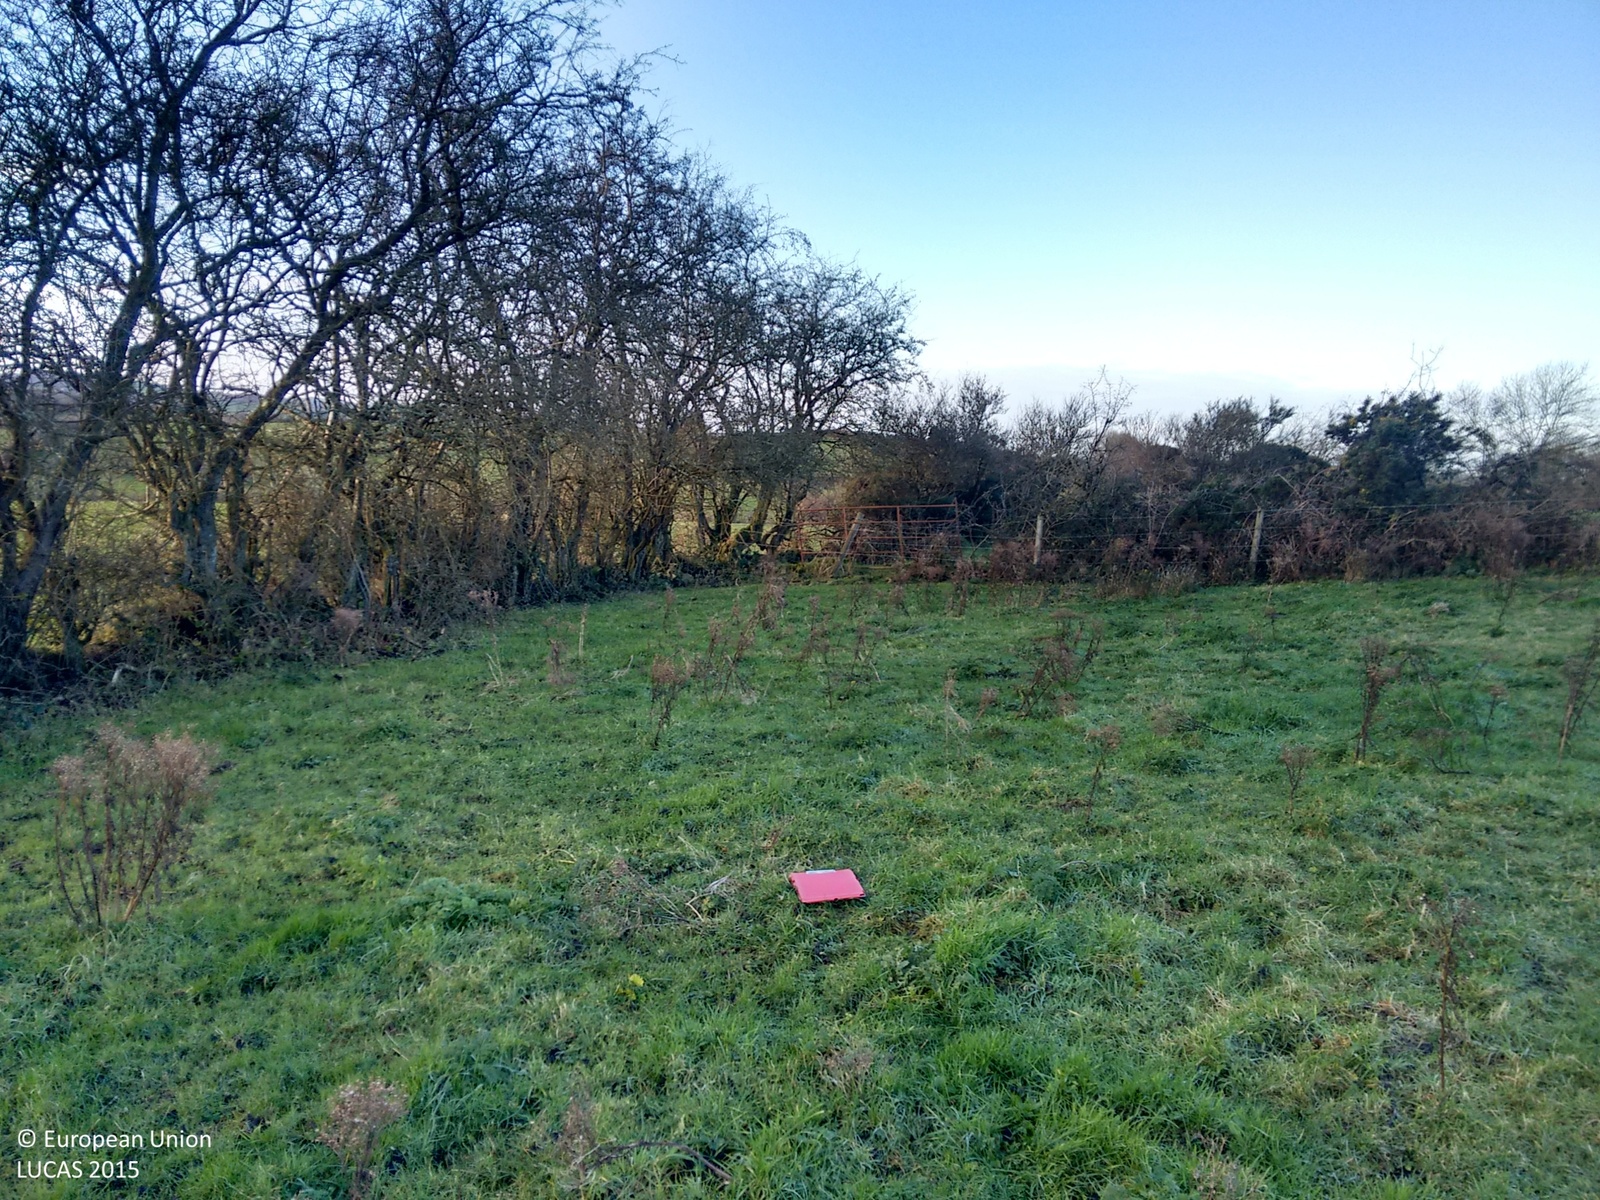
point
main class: Grassland
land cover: Grassland without tree/shrub cover
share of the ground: > 75 %
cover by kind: herbaceous plants 100 %
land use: Agriculture (excluding fallow land and kitchen gardens)
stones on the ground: < 10 %
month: December
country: IE
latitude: 53.9773
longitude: -6.8315
